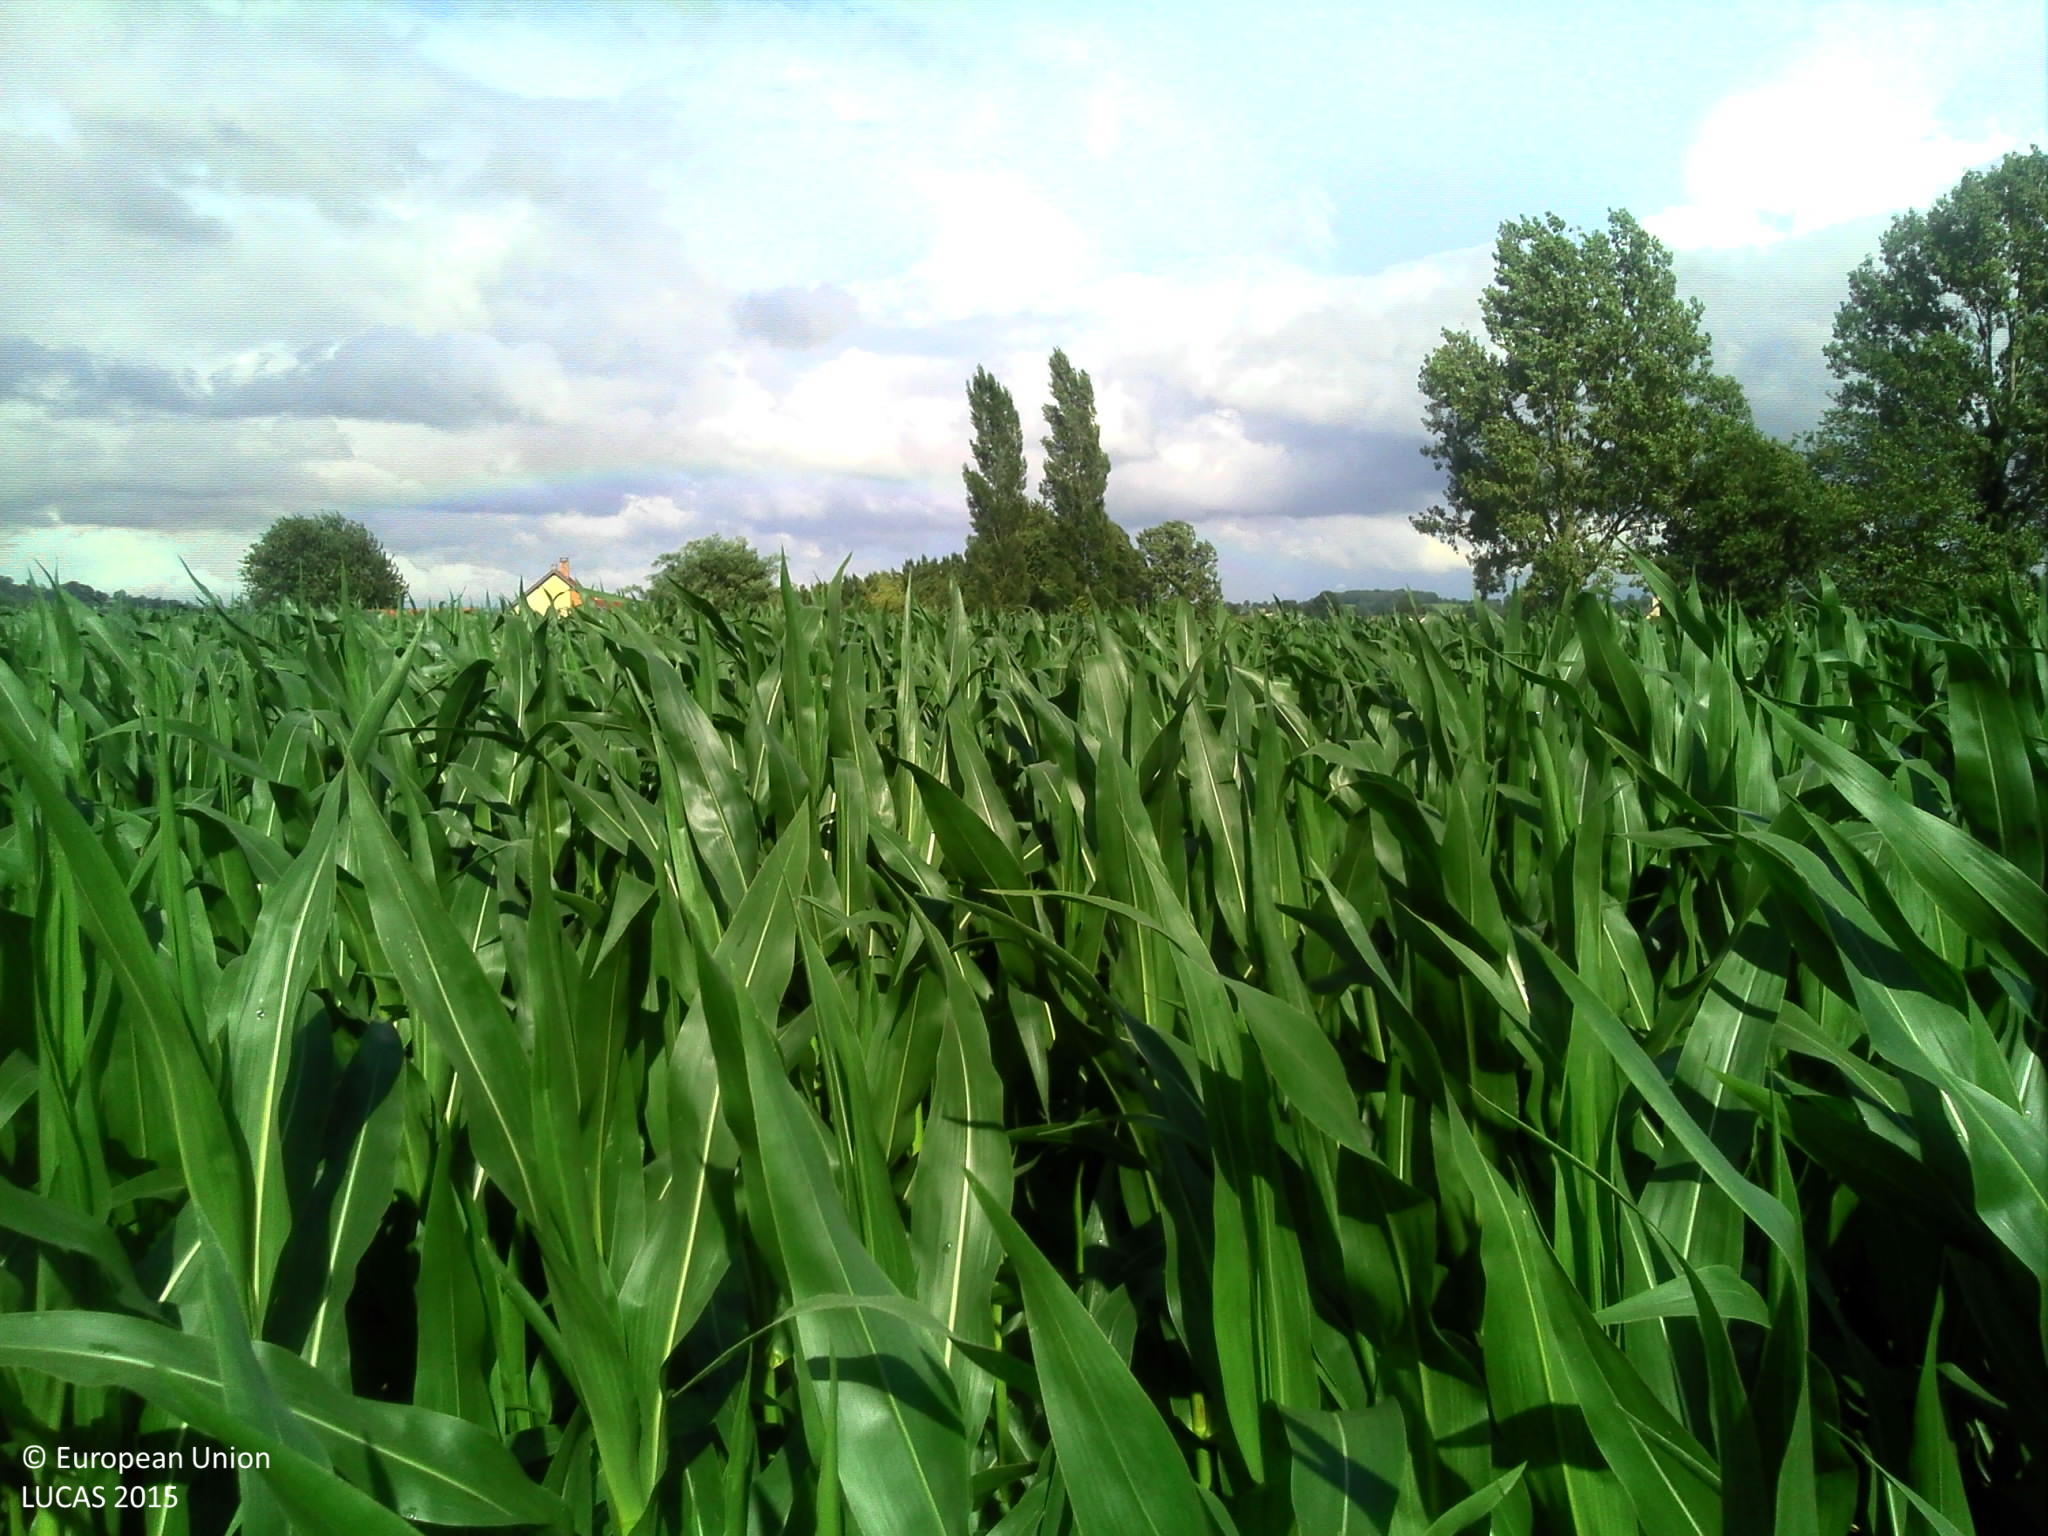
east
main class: Cropland
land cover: Maize
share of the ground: > 75 %
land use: Agriculture (excluding fallow land and kitchen gardens)
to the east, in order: Maize; Fences; Grassland with sparse tree/shrub cover; Electric lines; Grass margins; Paved roads, cycling and walking lanes; Grass margins; Other bare soil; Grass margins; Paved roads, cycling and walking lanes
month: July
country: FR
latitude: 48.7316
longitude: -1.2887
